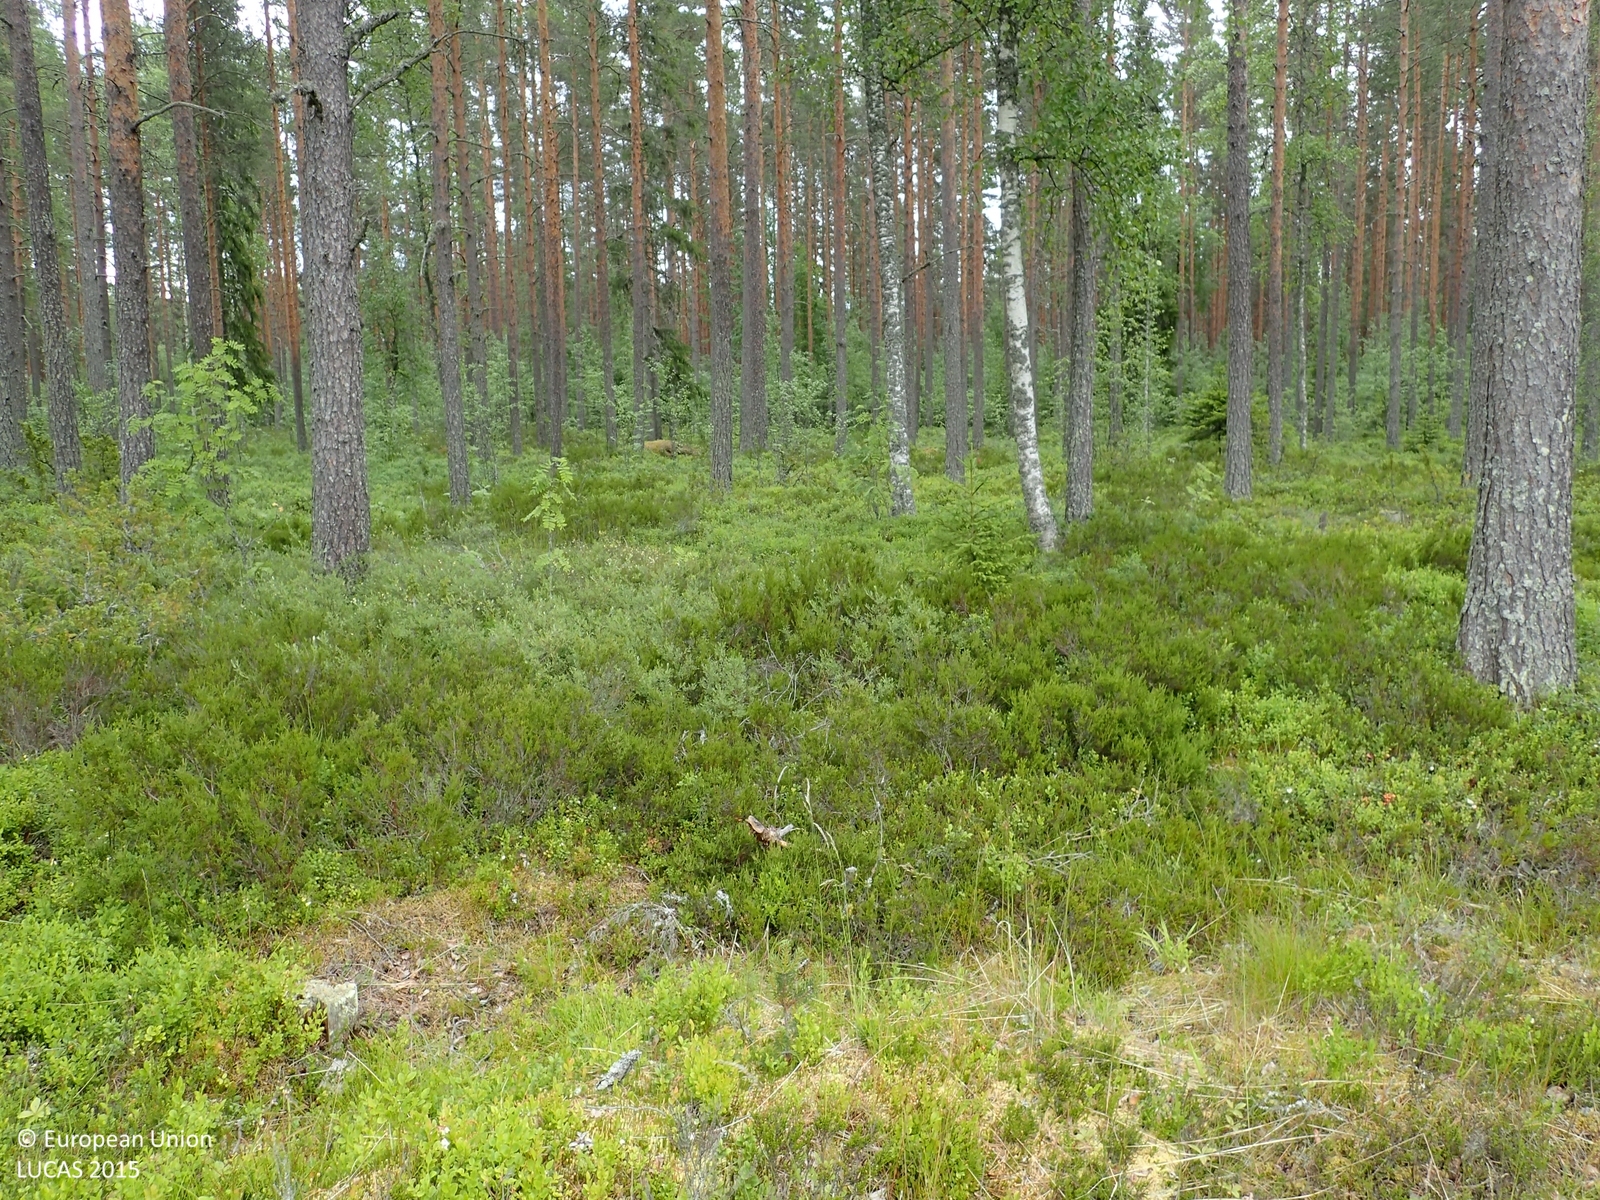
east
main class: Shrubland
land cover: Shrubland with sparse tree cover
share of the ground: > 75 %
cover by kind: shrubs 80 %, herbaceous plants 10 %, broadleaved forest trees 5 %, lichens and mosses 5 %
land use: Electricity, gas and thermal power distribution
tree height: < 5 m
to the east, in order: Shrubland with sparse tree cover; Pine dominated coniferous woodland; Ditches and canals; Pine dominated coniferous woodland; Ditches and canals; Pine dominated coniferous woodland
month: July
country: FI
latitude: 62.7371
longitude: 21.7262
